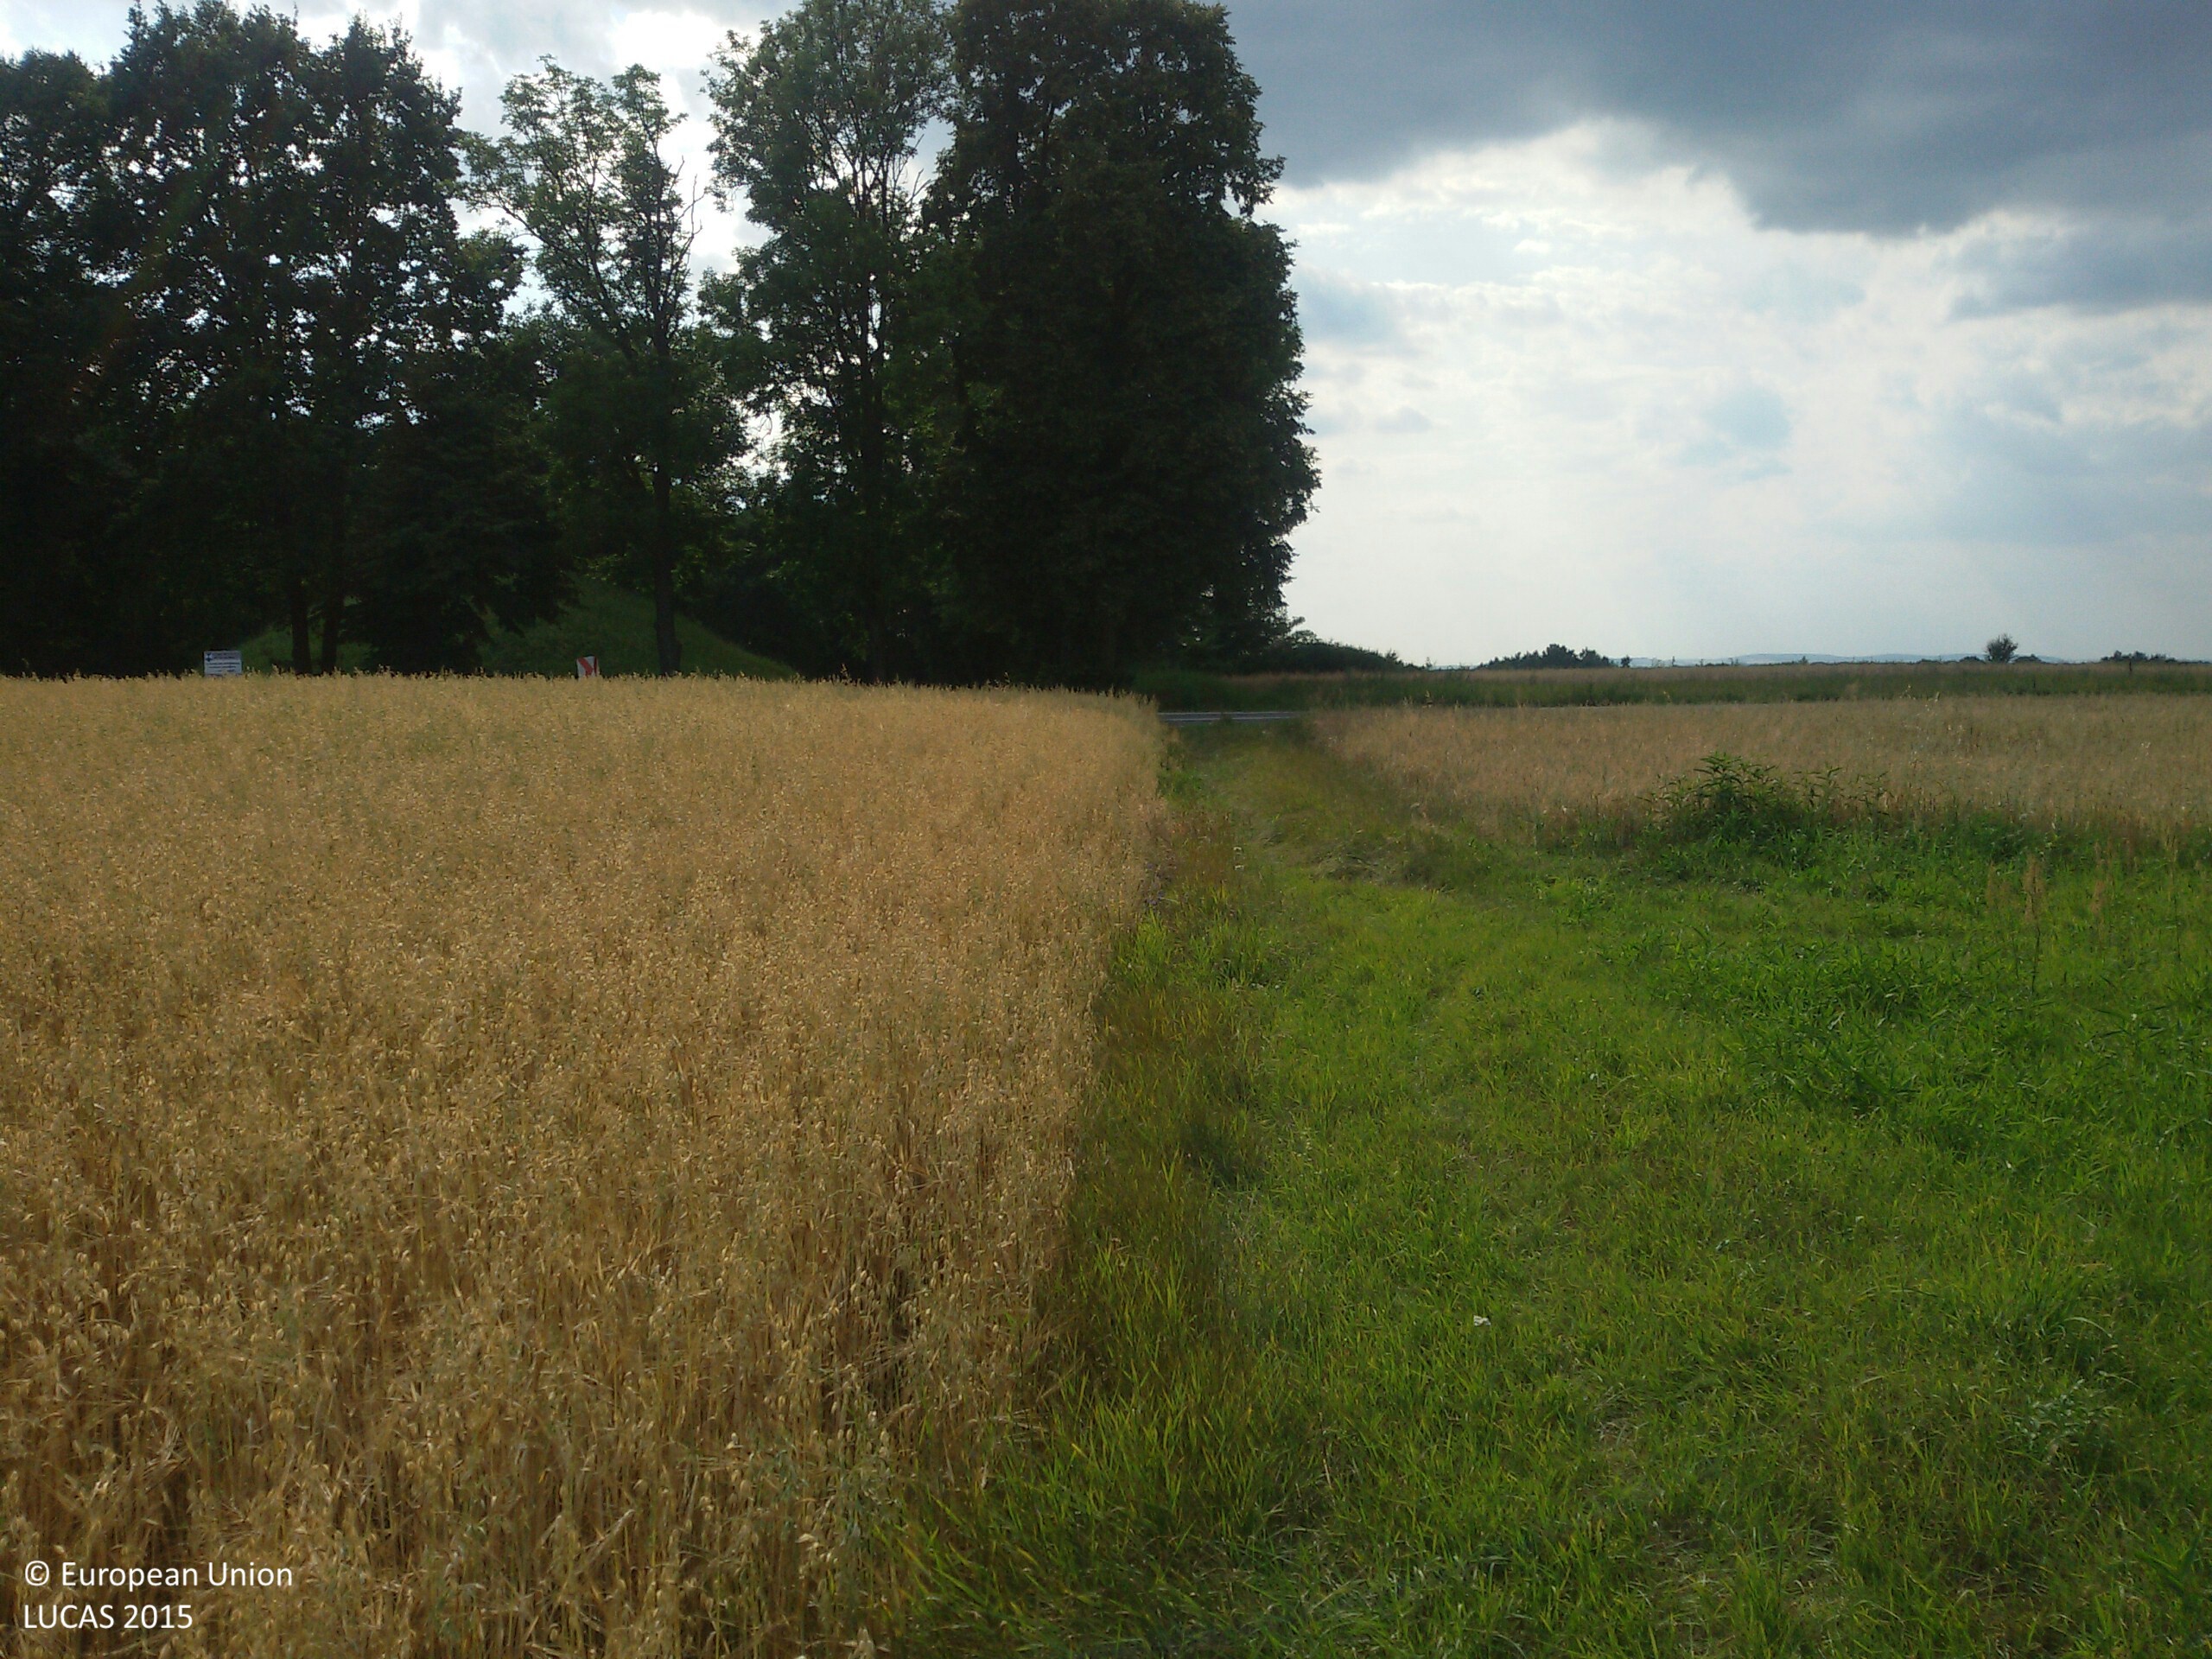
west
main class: Cropland
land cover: Oats
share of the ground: 50 - 75 %
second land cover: Barley
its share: 50 - 75 %
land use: Agriculture (excluding fallow land and kitchen gardens)
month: July
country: PL
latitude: 50.3241
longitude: 20.7865
